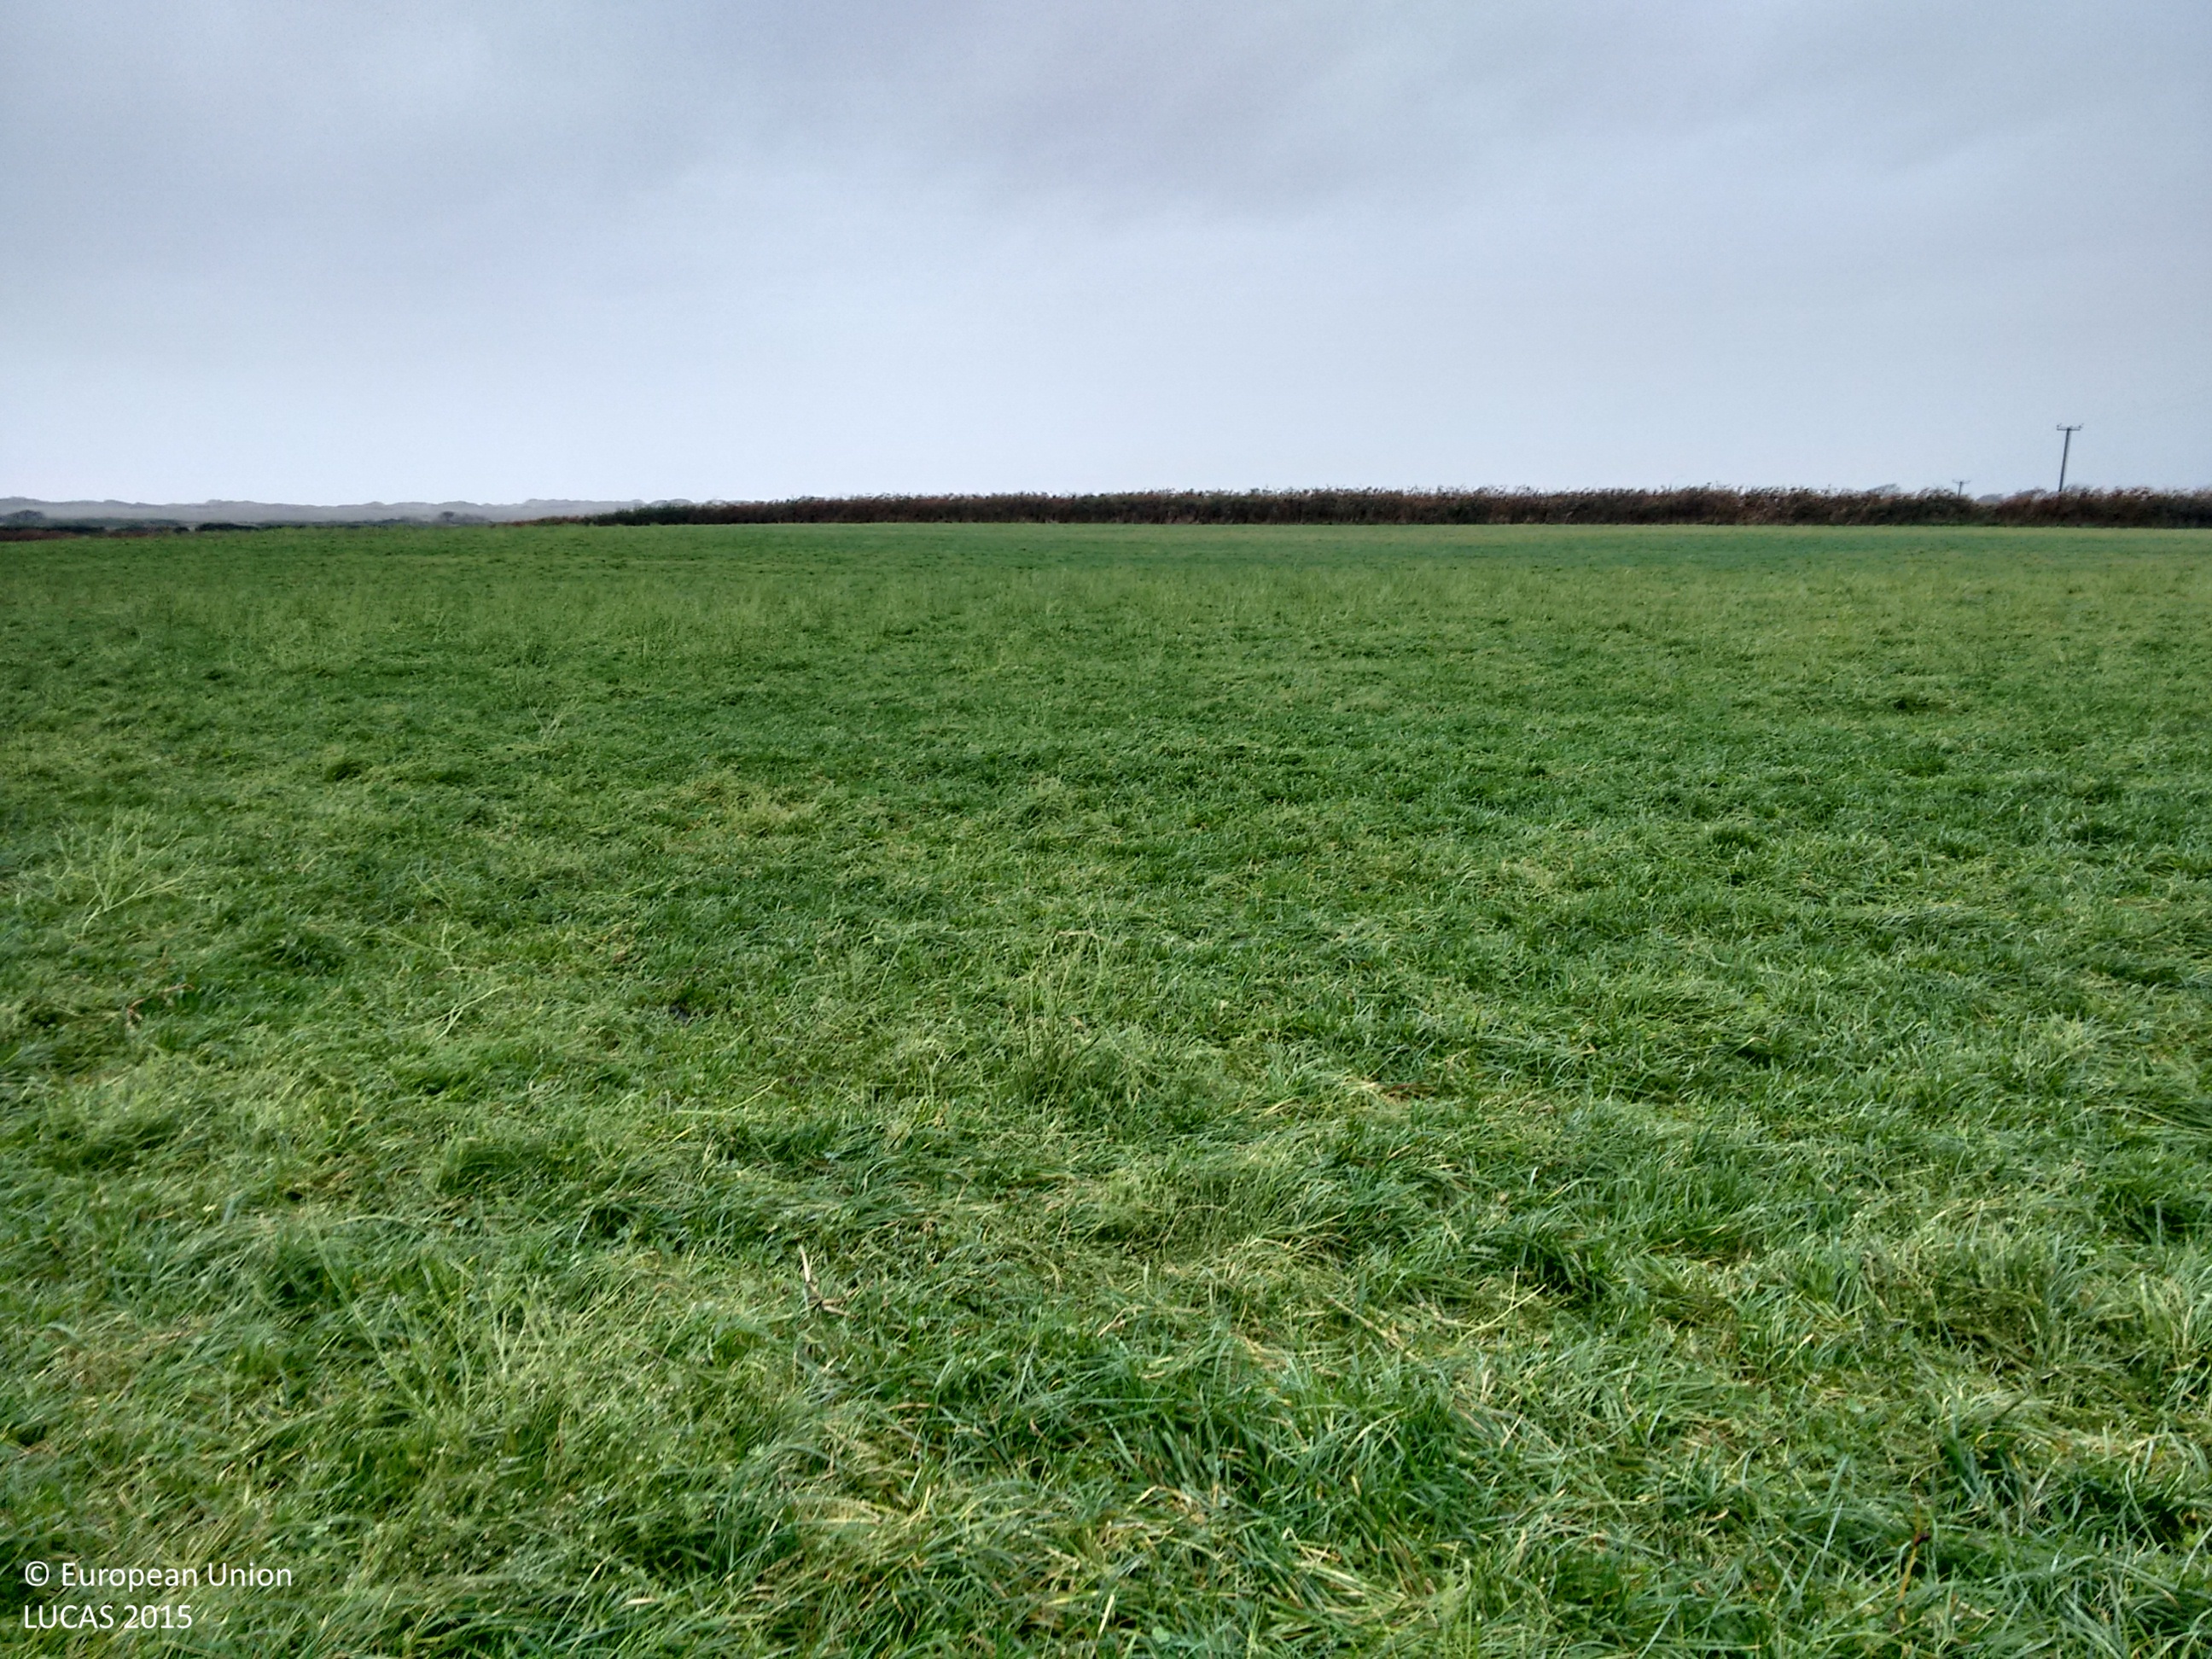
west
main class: Grassland
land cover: Grassland without tree/shrub cover
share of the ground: > 75 %
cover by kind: herbaceous plants 100 %
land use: Agriculture (excluding fallow land and kitchen gardens)
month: November
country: GB
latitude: 54.3648
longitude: -3.4244
